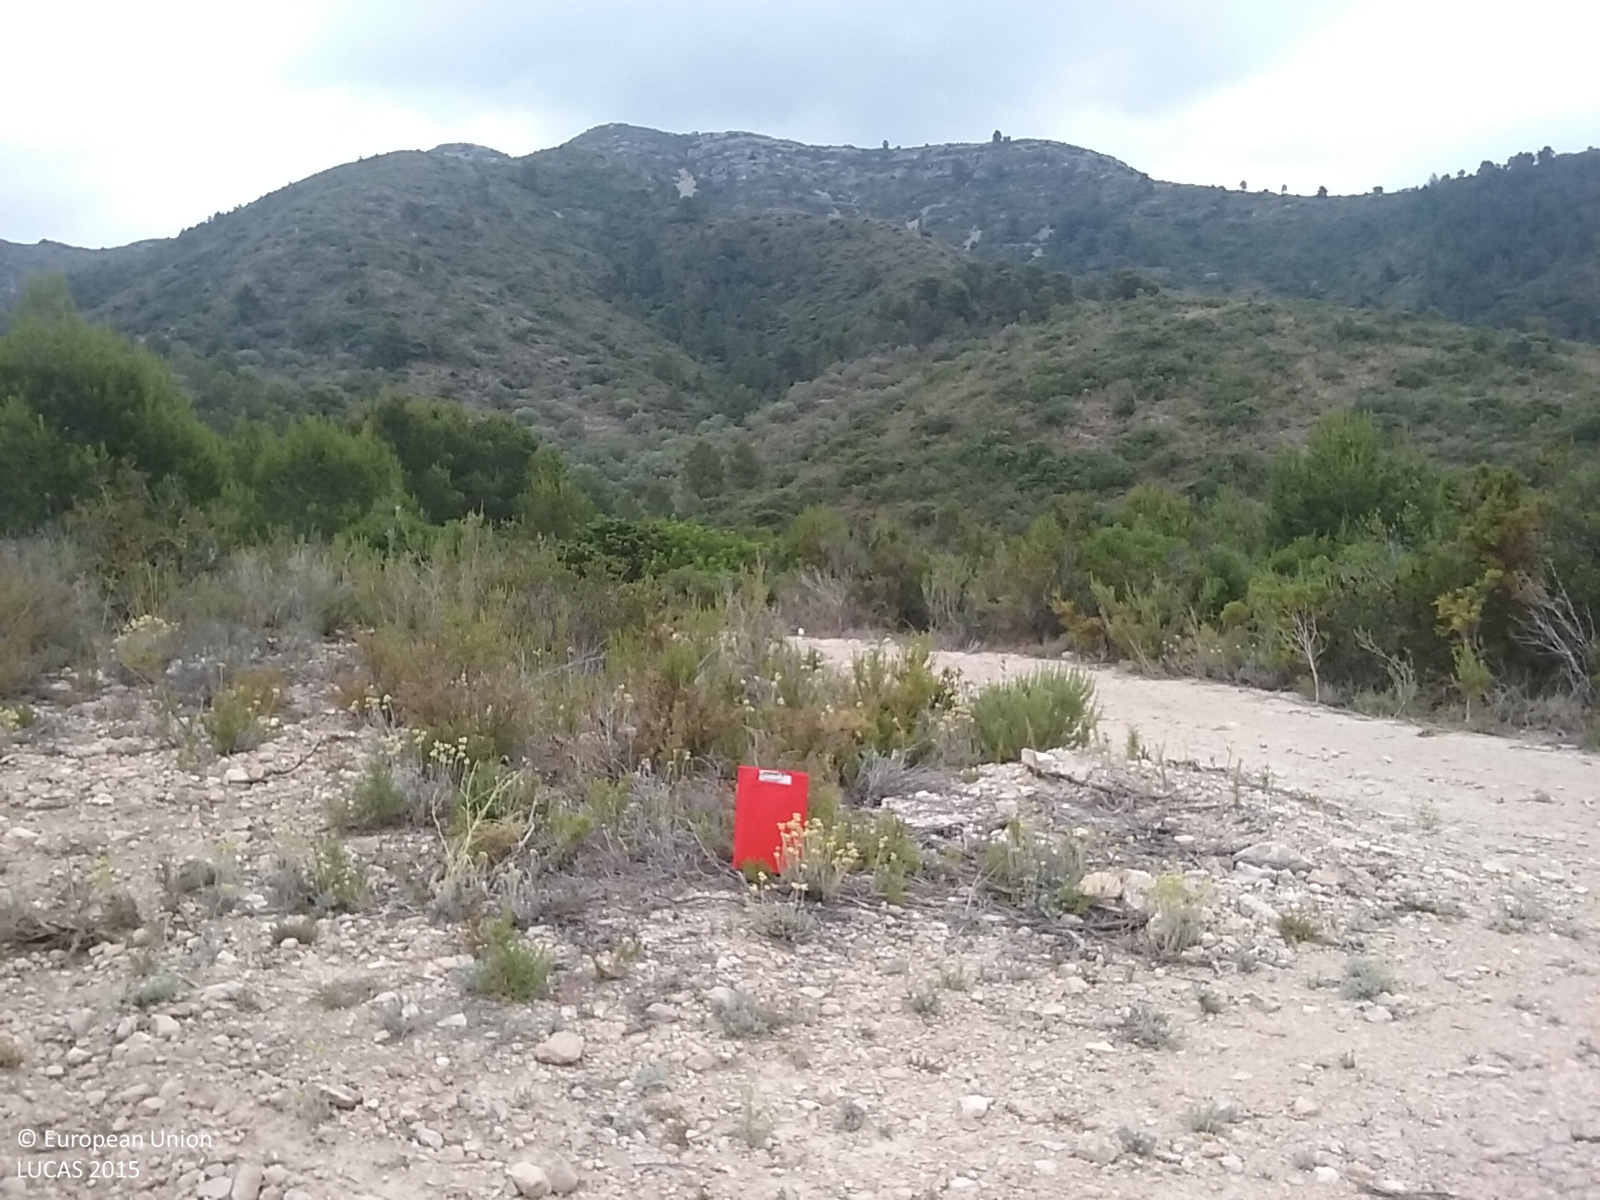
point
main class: Shrubland
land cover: Shrubland with sparse tree cover
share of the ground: 25 - 50 %
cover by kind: shrubs 50 %, unconsolidated bare surface 45 %, coniferous forest trees 5 %
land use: Semi-natural and natural areas not in use
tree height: < 5 m
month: June
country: ES
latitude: 40.8848
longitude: 0.5584
